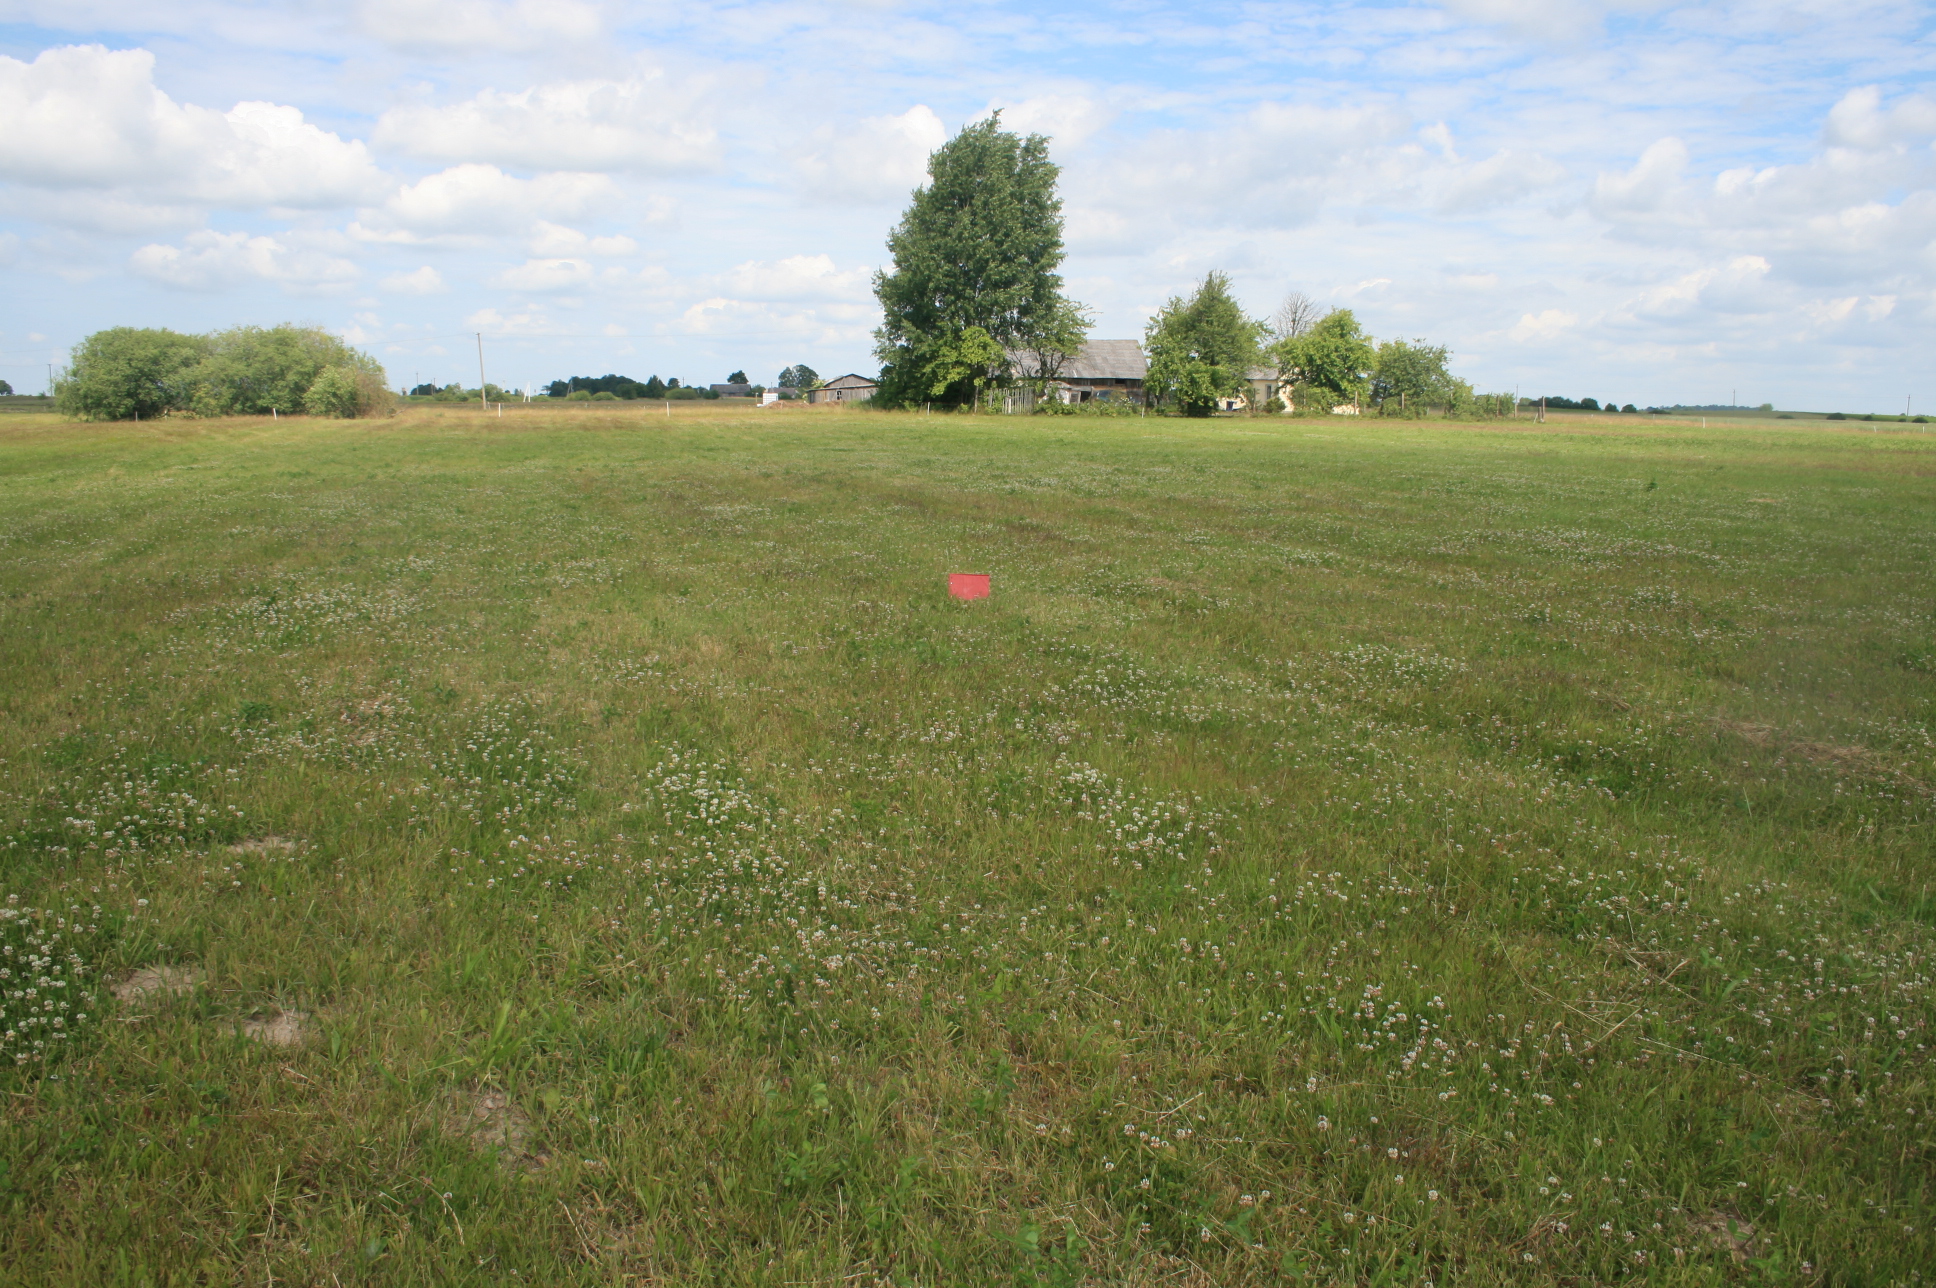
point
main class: Grassland
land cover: Grassland without tree/shrub cover
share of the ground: > 75 %
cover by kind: herbaceous plants 100 %
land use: Agriculture (excluding fallow land and kitchen gardens)
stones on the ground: < 10 %
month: June
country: LT
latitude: 55.3205
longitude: 21.7270
